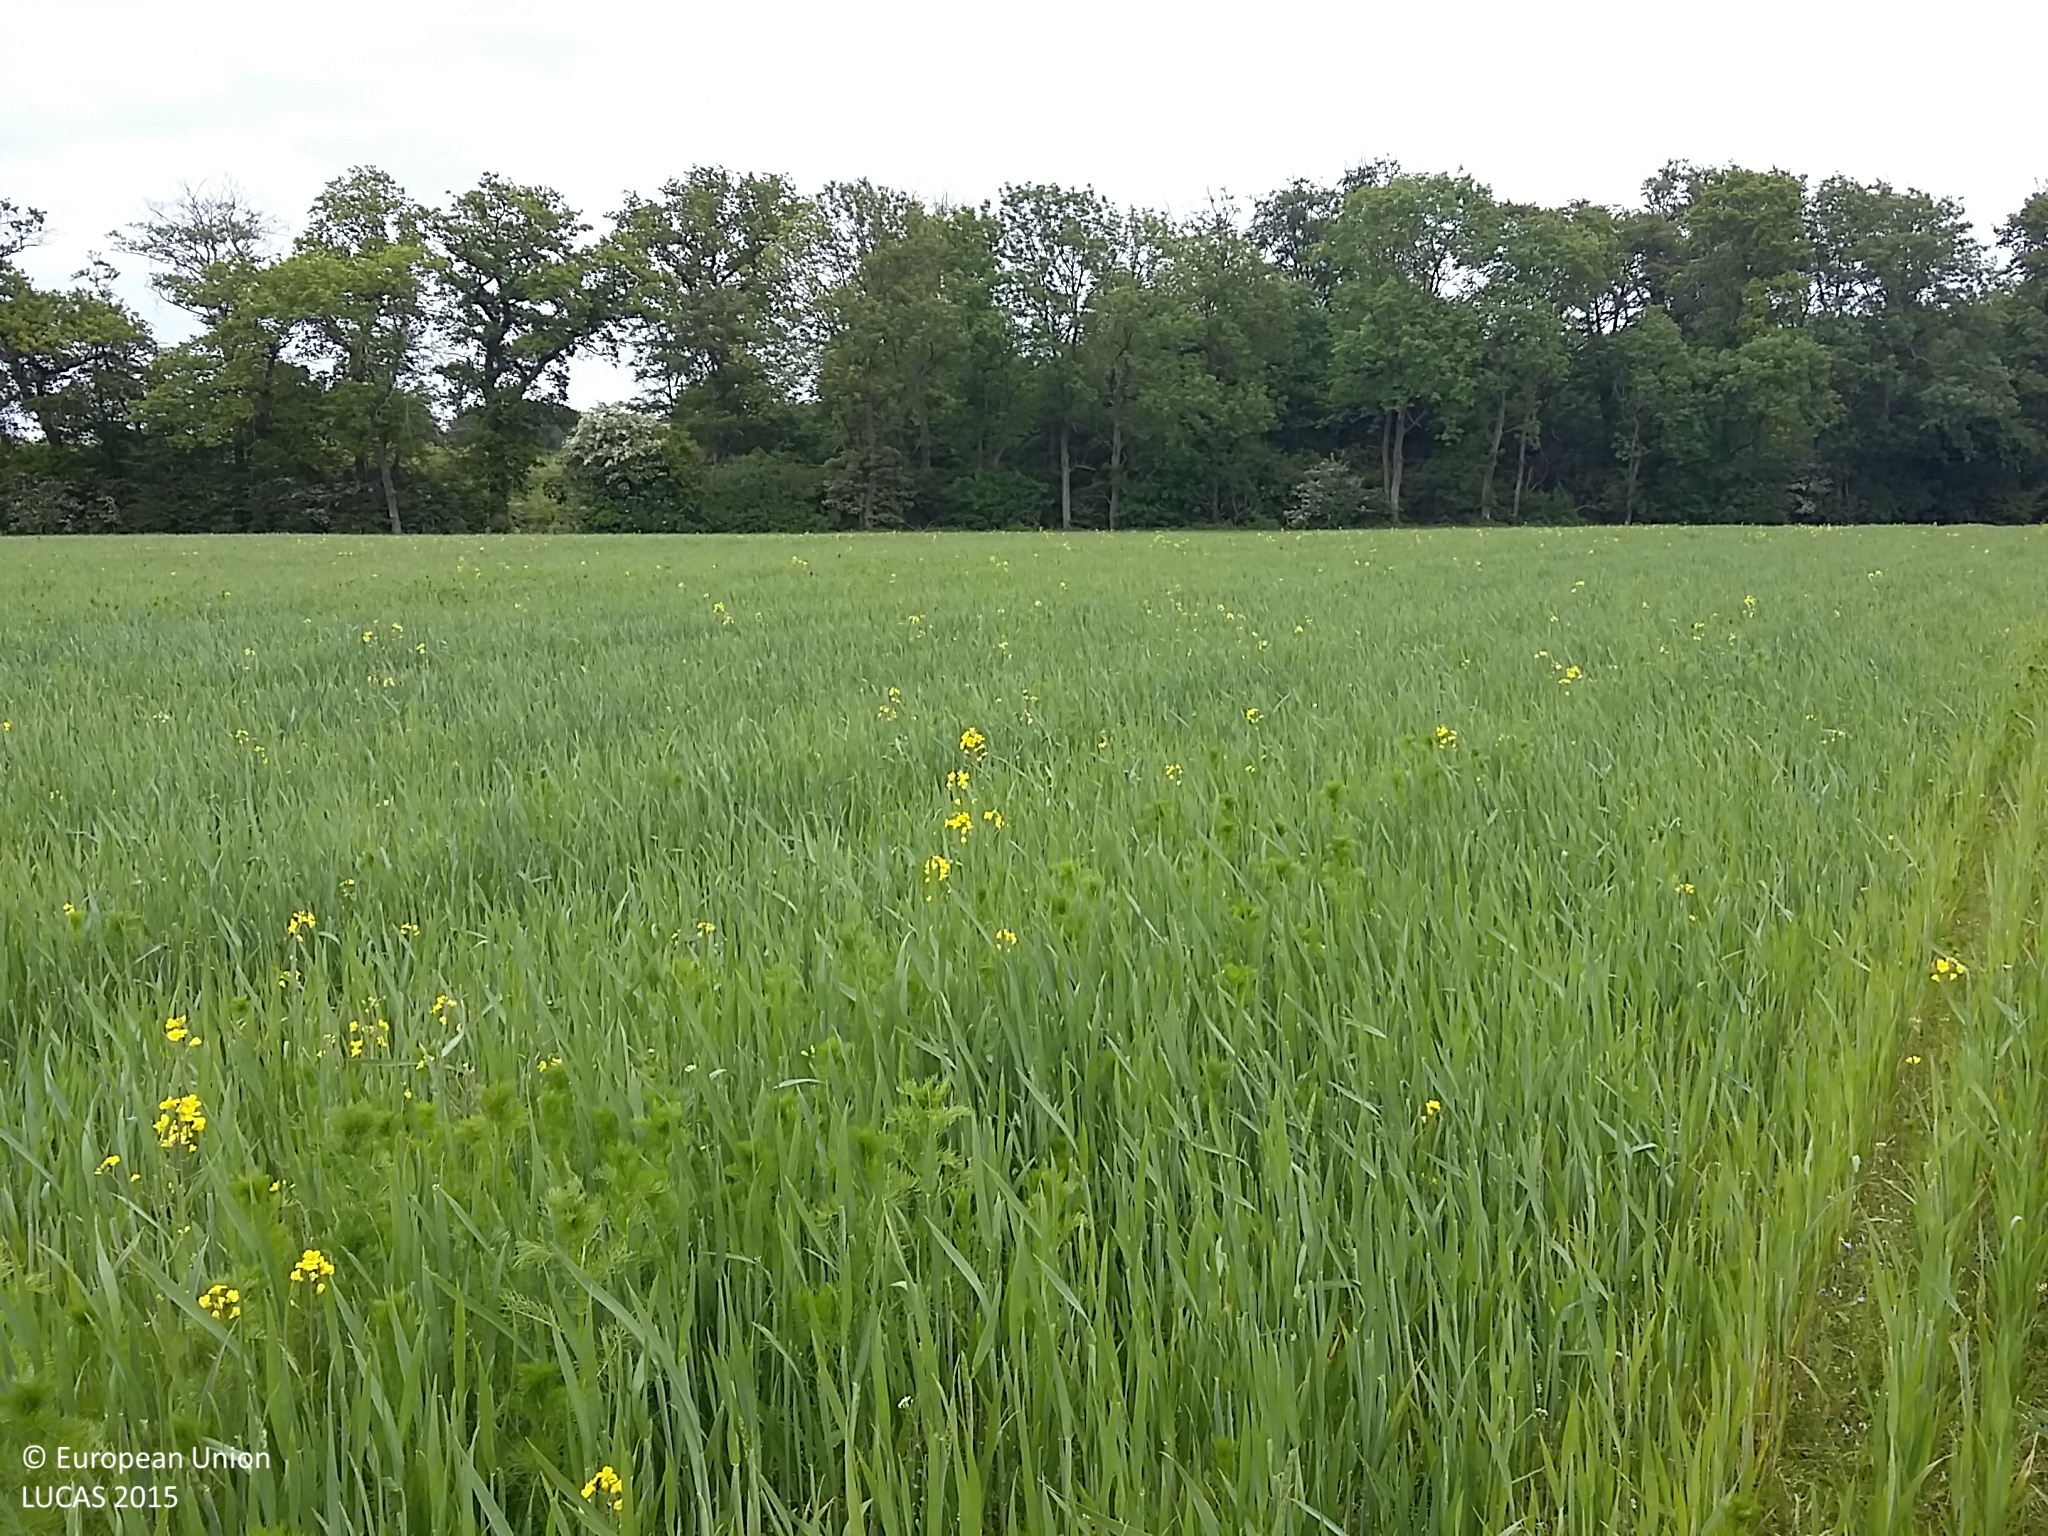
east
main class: Cropland
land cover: Common wheat
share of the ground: > 75 %
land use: Agriculture (excluding fallow land and kitchen gardens)
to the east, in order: Common wheat; Tracks; Broadleaved woodland; Tracks; Grass margins; Fences; Spontaneously vegetated surfaces; Fences; Broadleaved woodland; Tracks; Fences; Broadleaved woodland
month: June
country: DK
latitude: 55.4310
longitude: 10.6789
